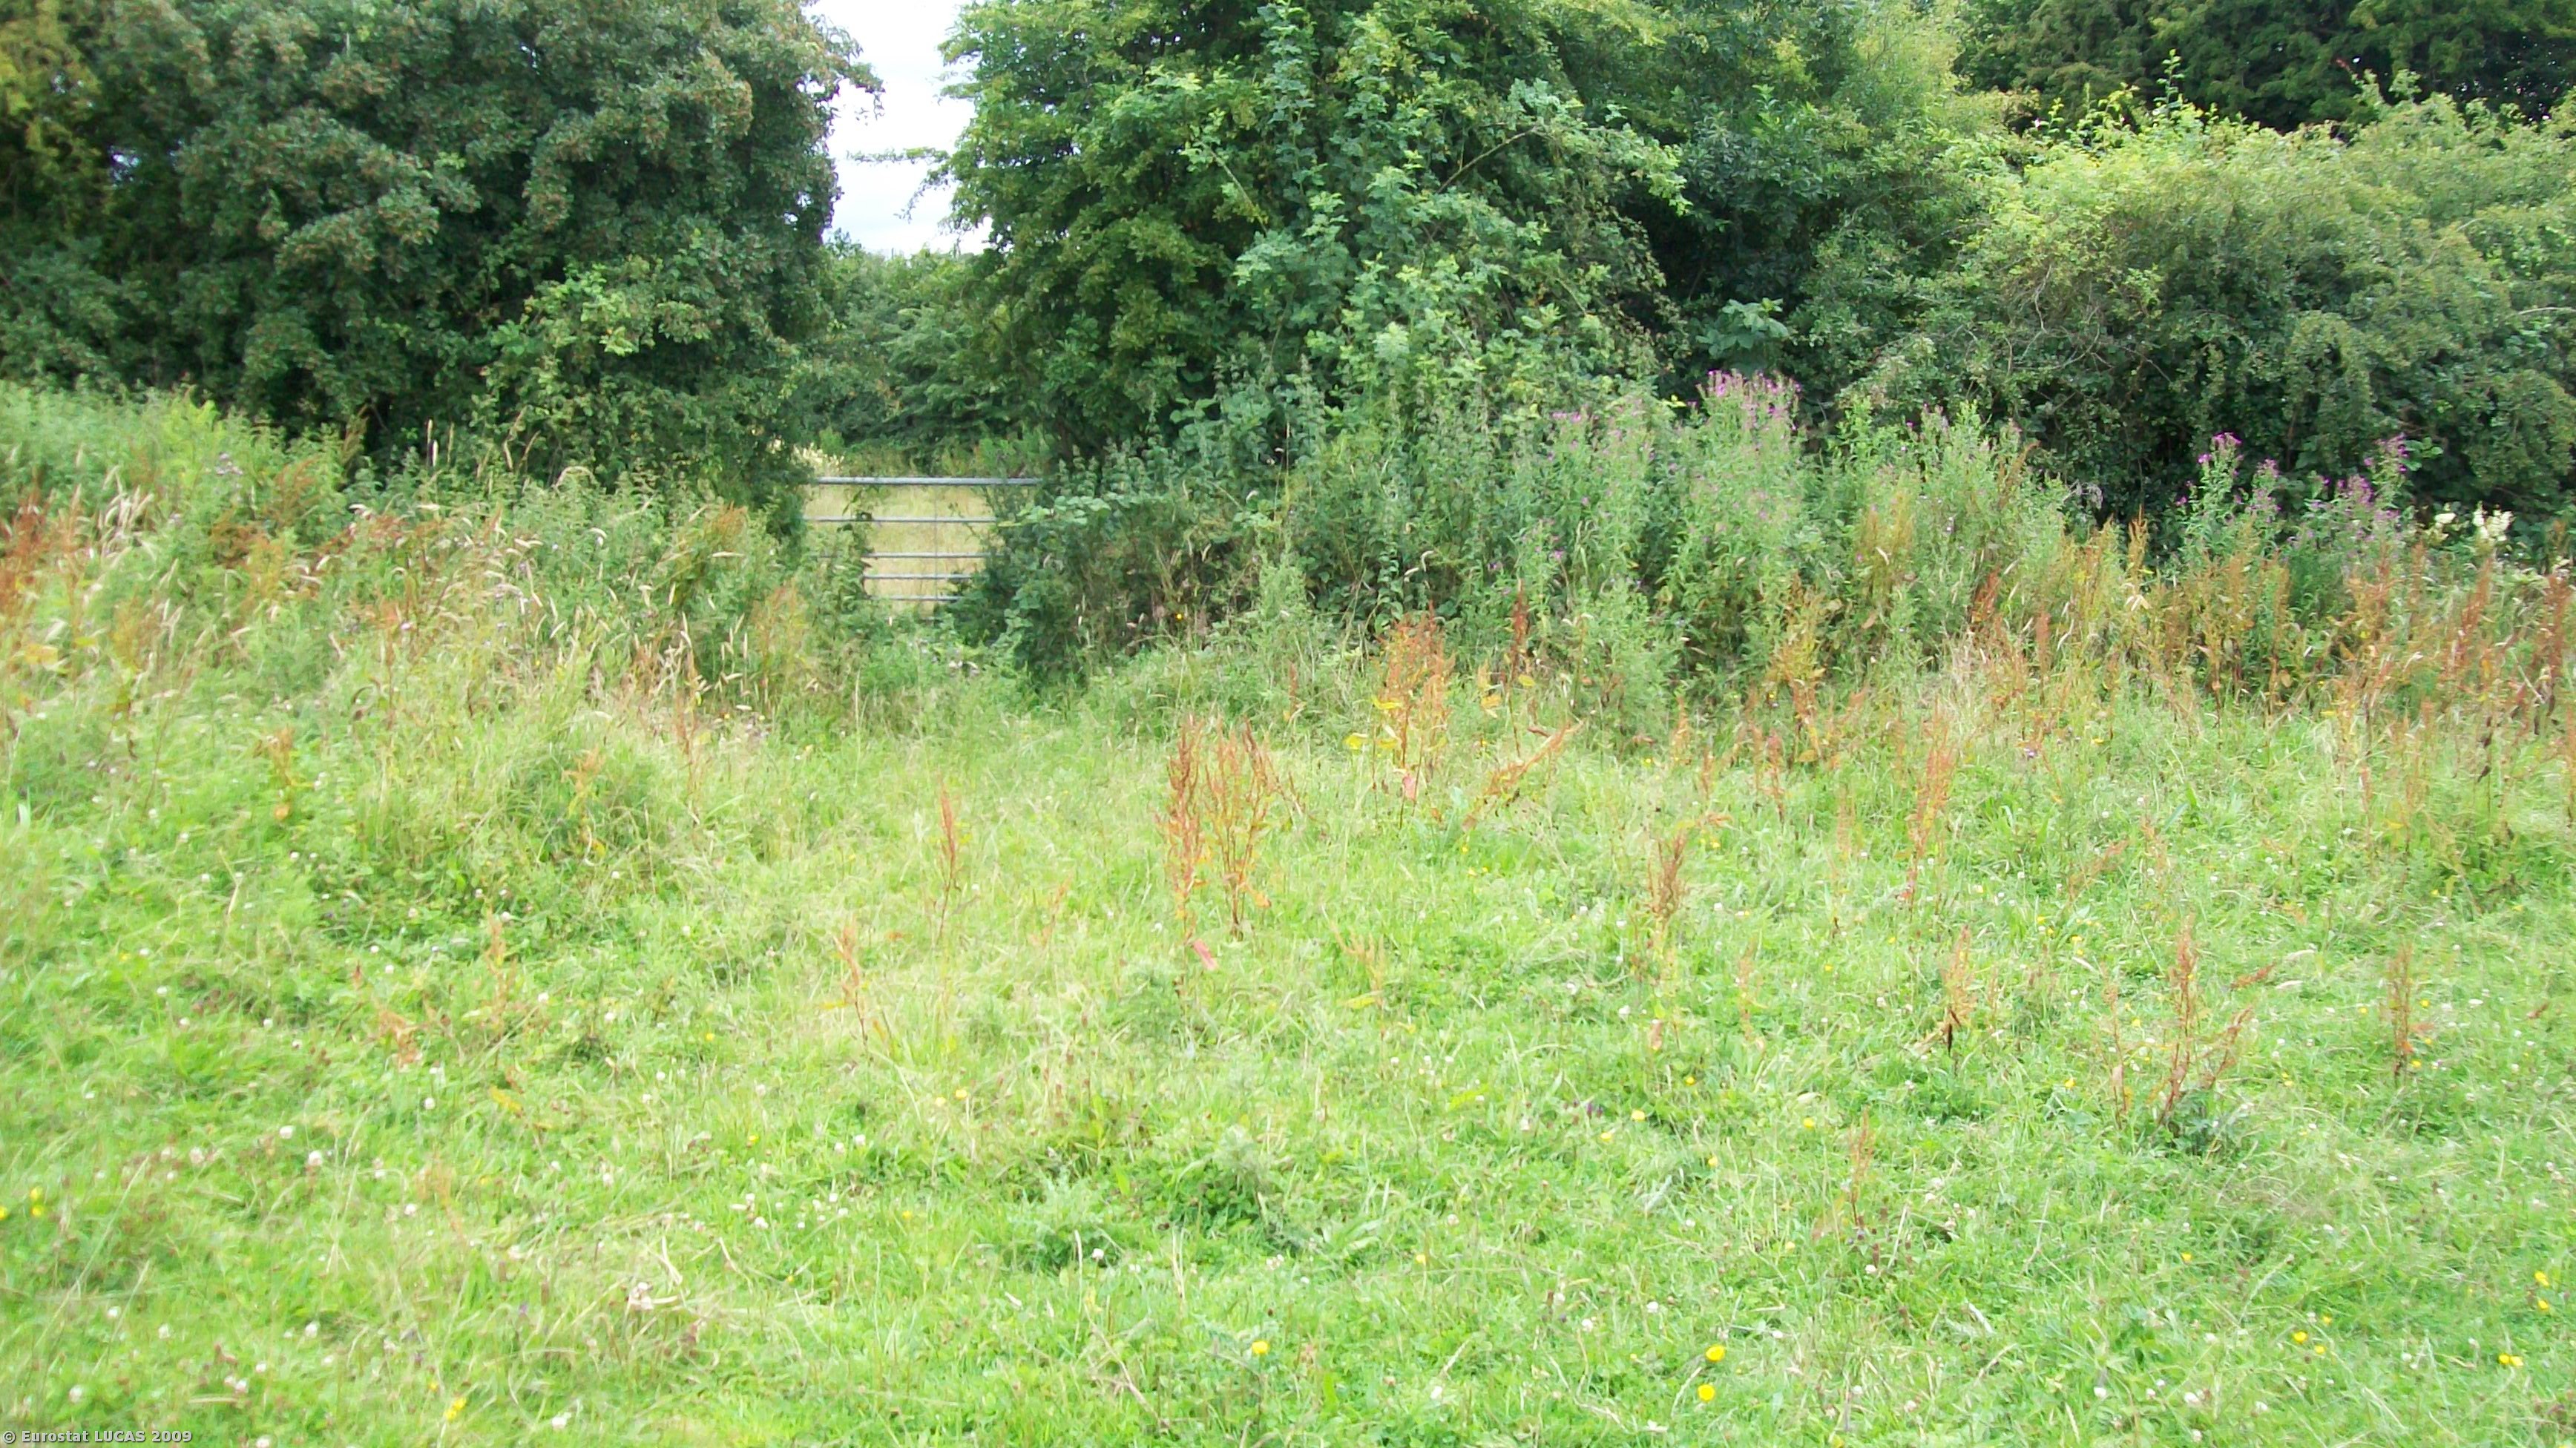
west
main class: Grassland
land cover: Grassland without tree/shrub cover
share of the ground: > 75 %
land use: Agriculture (excluding fallow land and kitchen gardens)
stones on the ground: < 10 %
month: July
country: GB
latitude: 53.1458
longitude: -1.2756
